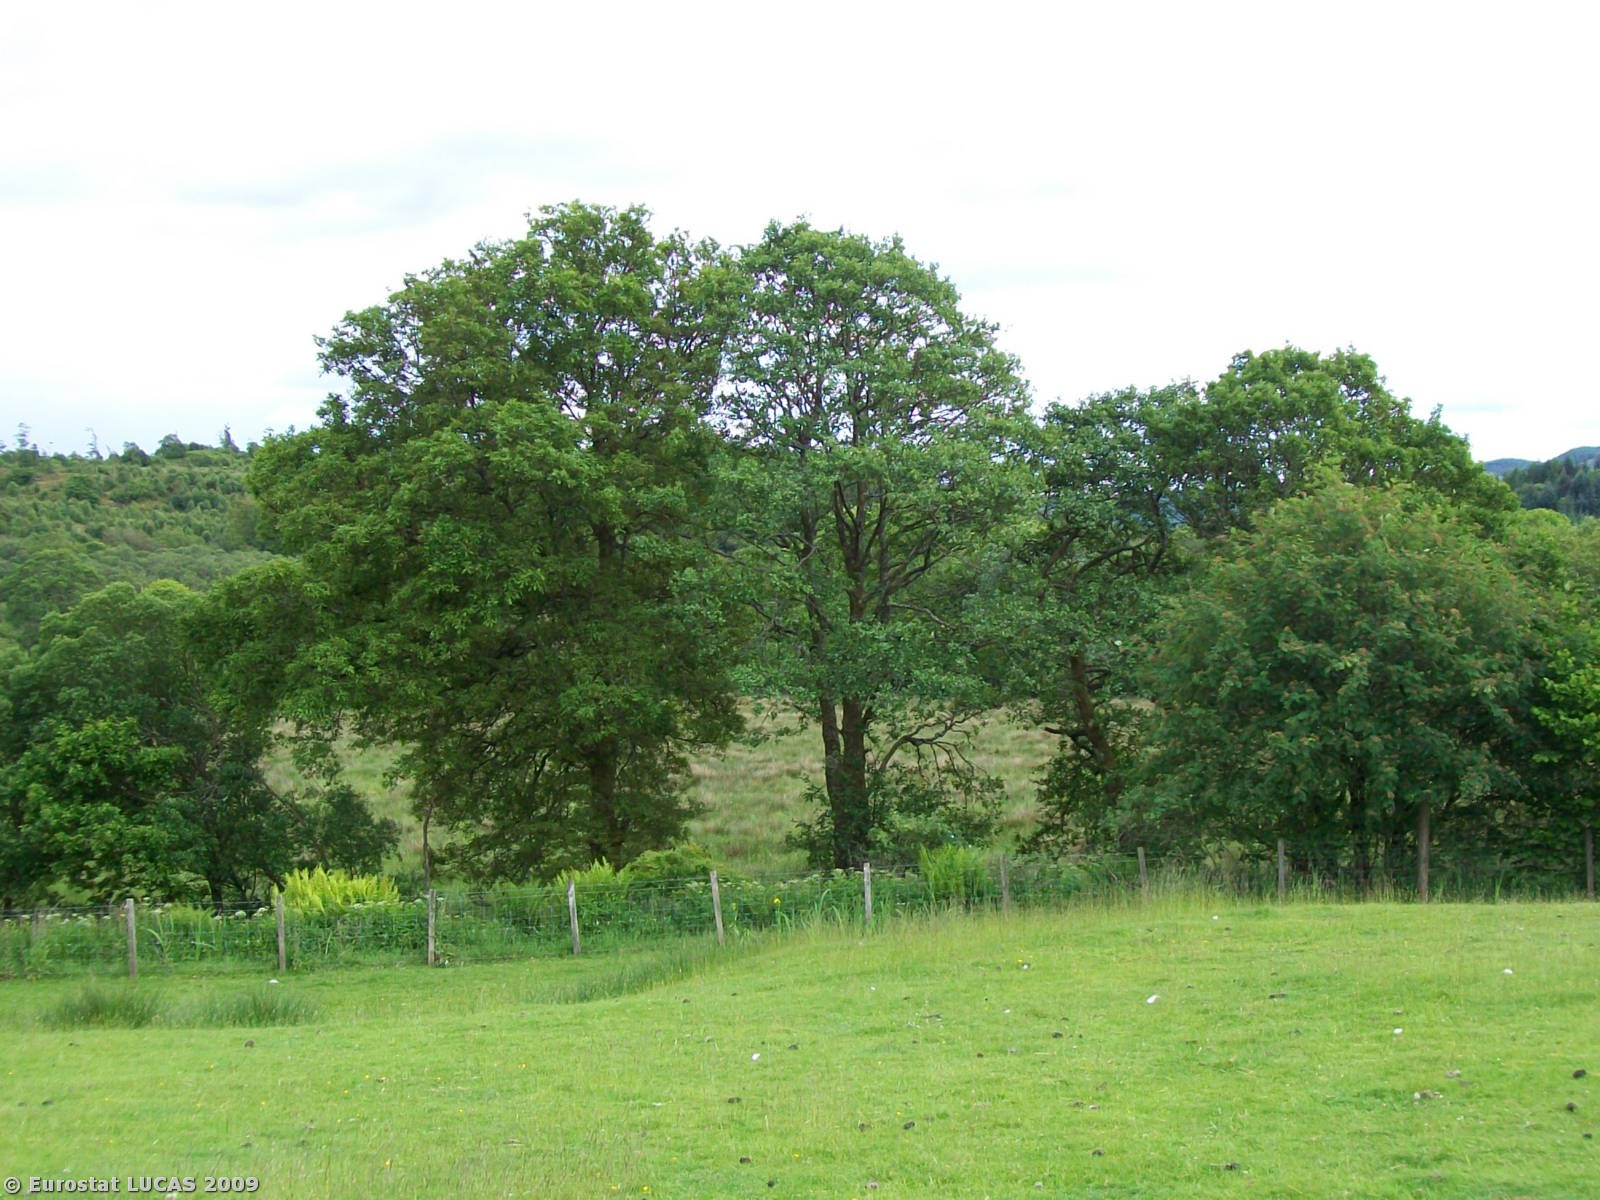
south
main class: Grassland
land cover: Grassland without tree/shrub cover
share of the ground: > 75 %
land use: Agriculture (excluding fallow land and kitchen gardens)
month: June
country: GB
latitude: 56.5360
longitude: -5.3859
